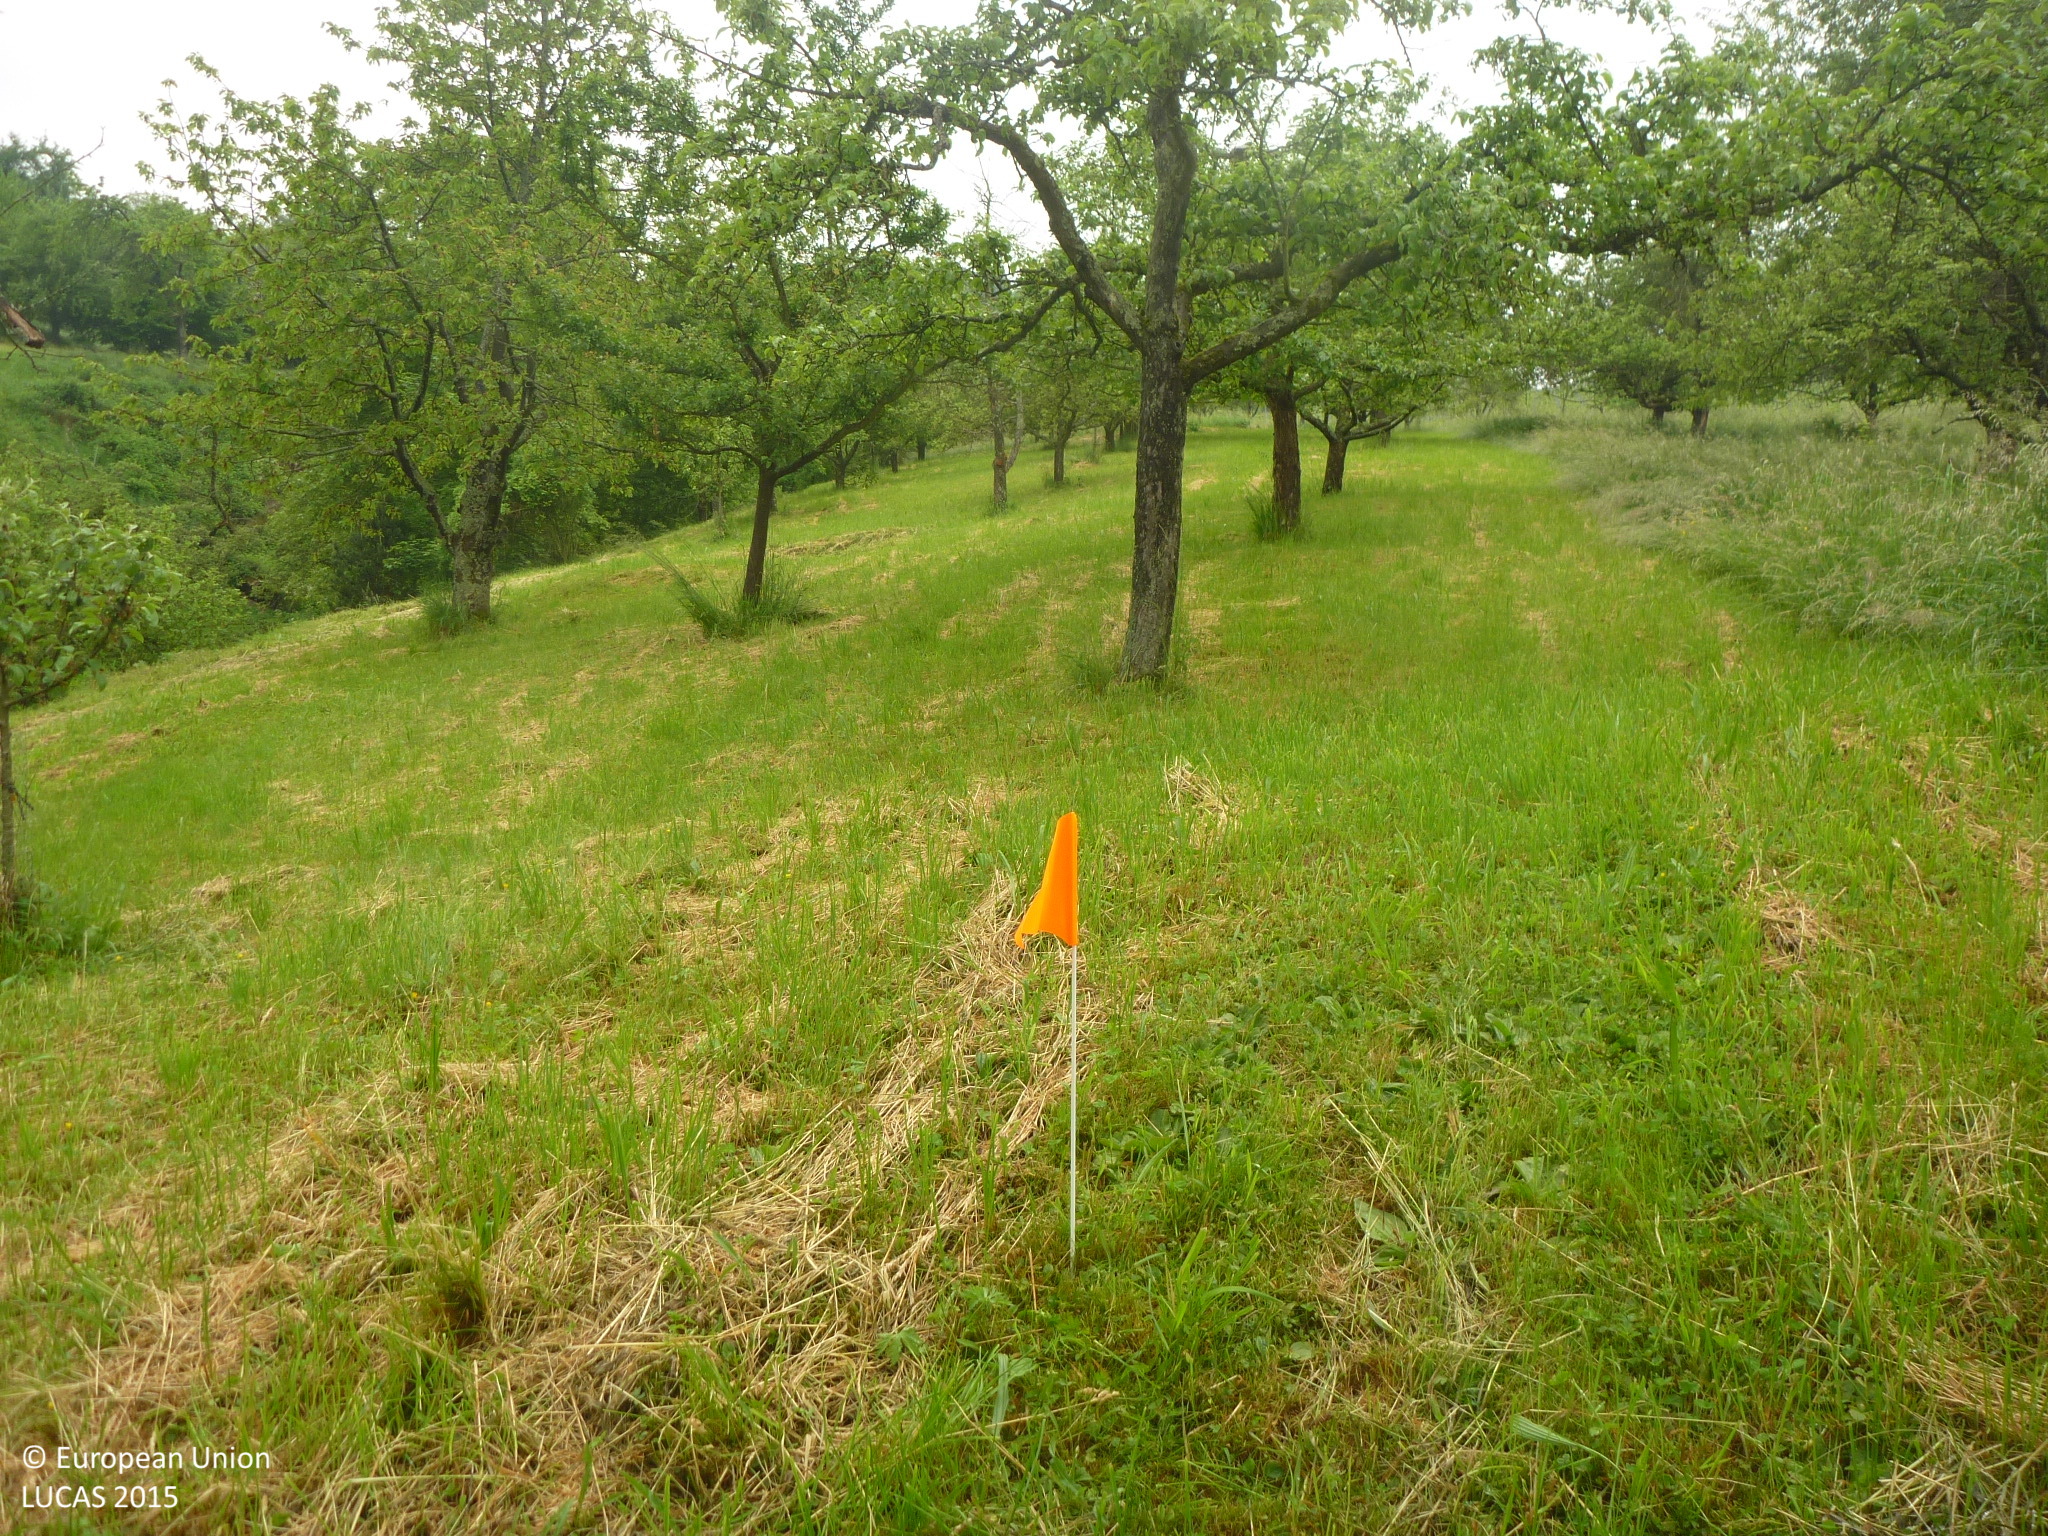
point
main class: Cropland
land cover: Apple fruit
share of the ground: 50 - 75 %
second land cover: Grassland without tree/shrub cover
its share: > 75 %
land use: Agriculture (excluding fallow land and kitchen gardens)
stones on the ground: < 10 %
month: May
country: DE
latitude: 48.7793
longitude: 9.3335
